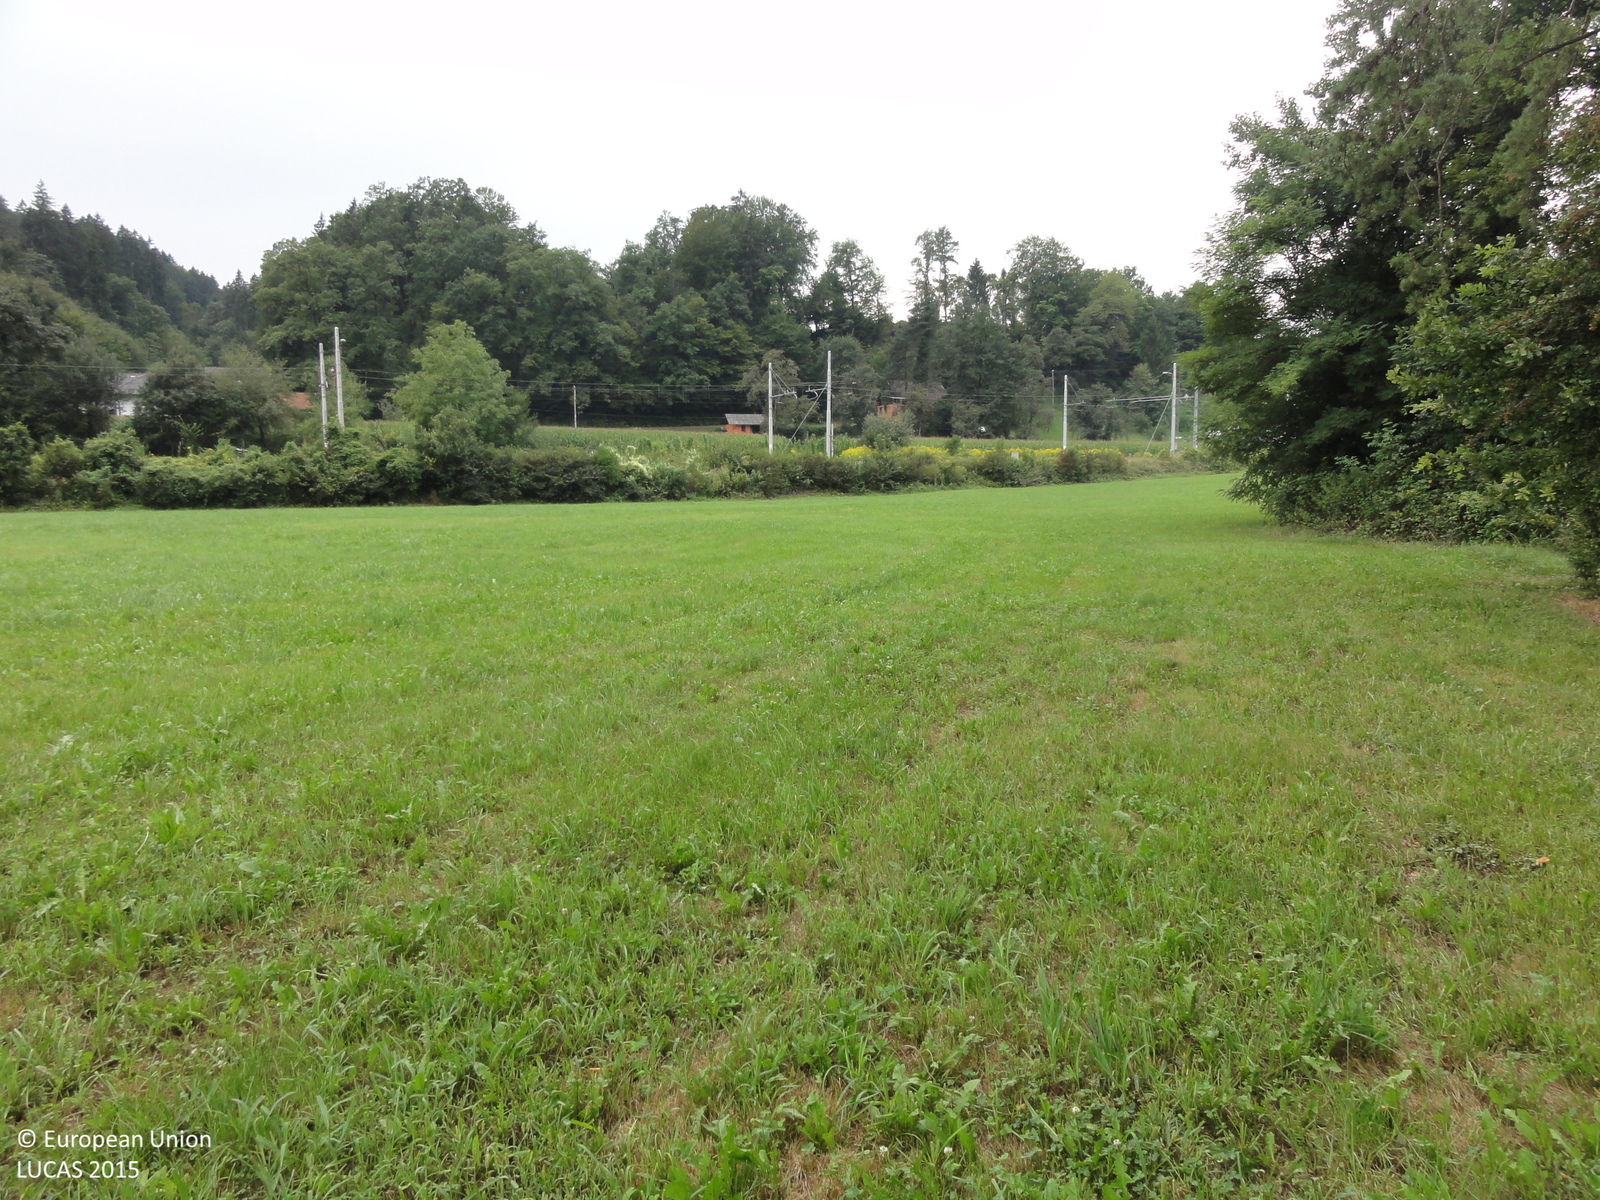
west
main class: Grassland
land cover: Grassland without tree/shrub cover
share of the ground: > 75 %
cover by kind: herbaceous plants 100 %
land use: Agriculture (excluding fallow land and kitchen gardens)
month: August
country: SI
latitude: 46.0993
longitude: 14.7959
